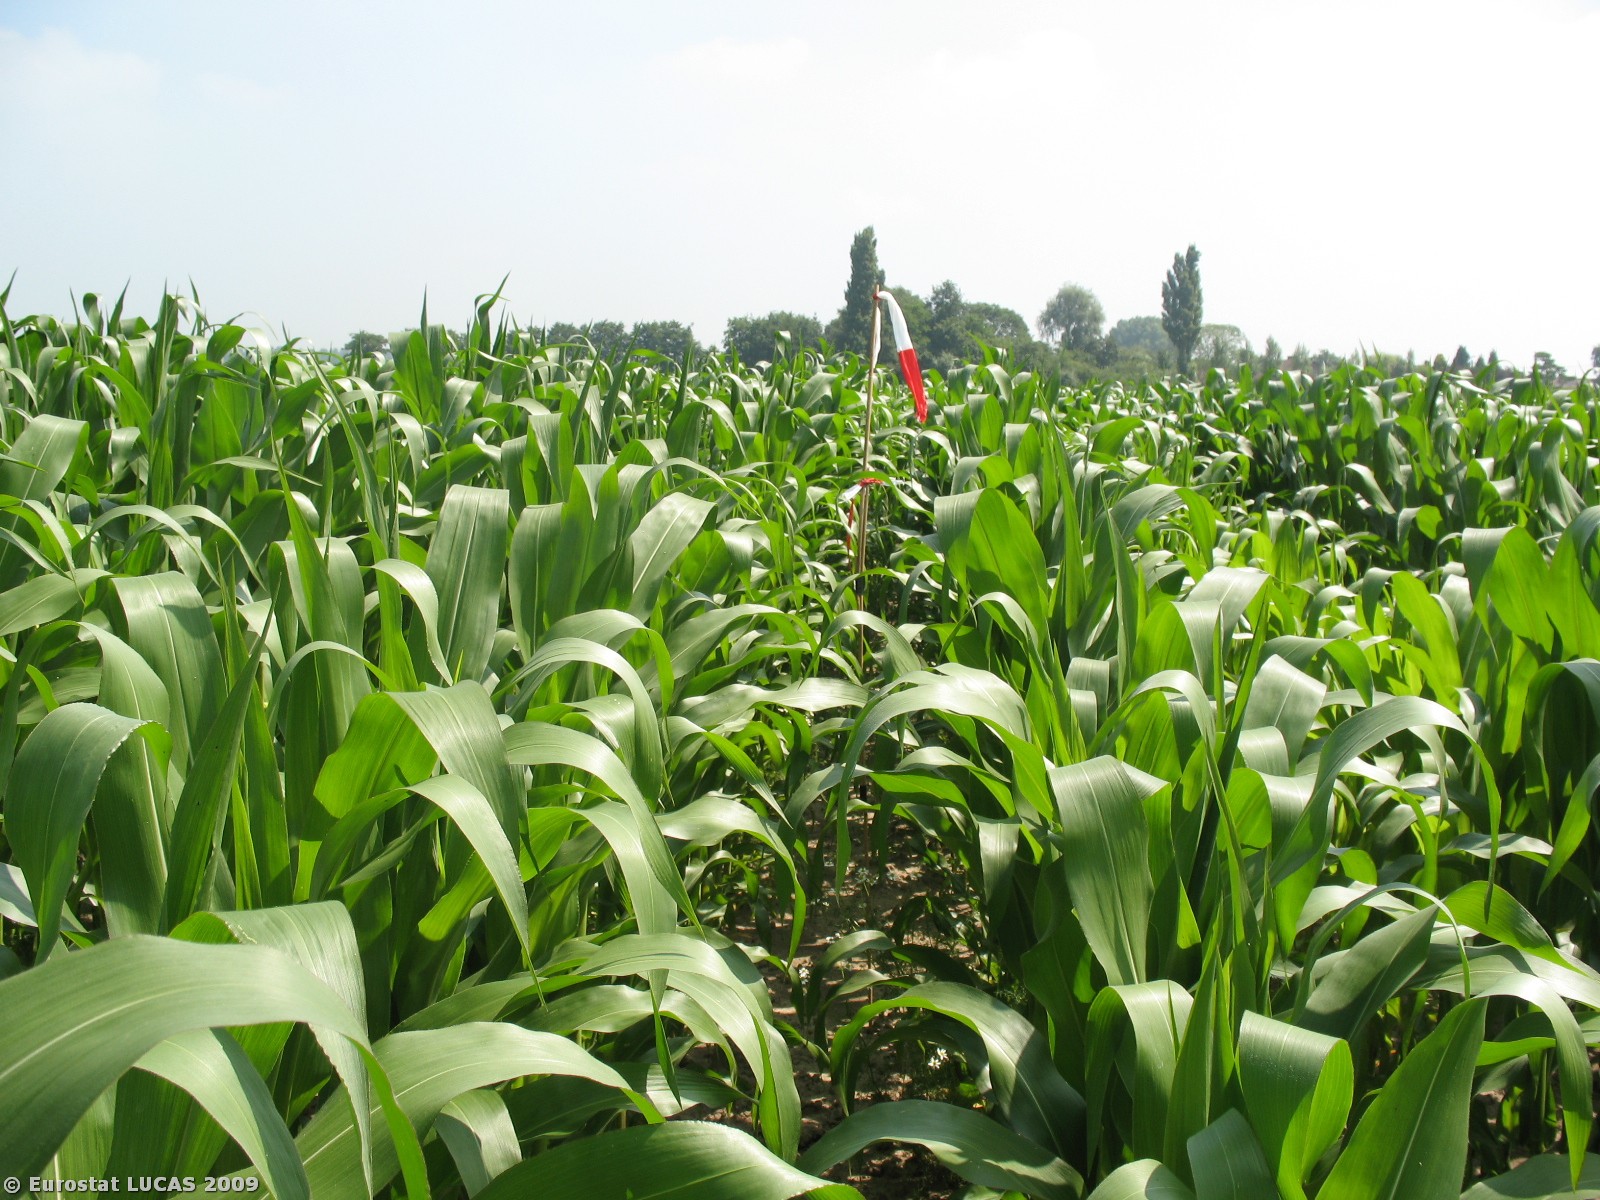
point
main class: Cropland
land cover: Maize
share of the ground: > 75 %
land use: Agriculture (excluding fallow land and kitchen gardens)
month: June
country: BE
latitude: 51.2531
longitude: 3.6742
